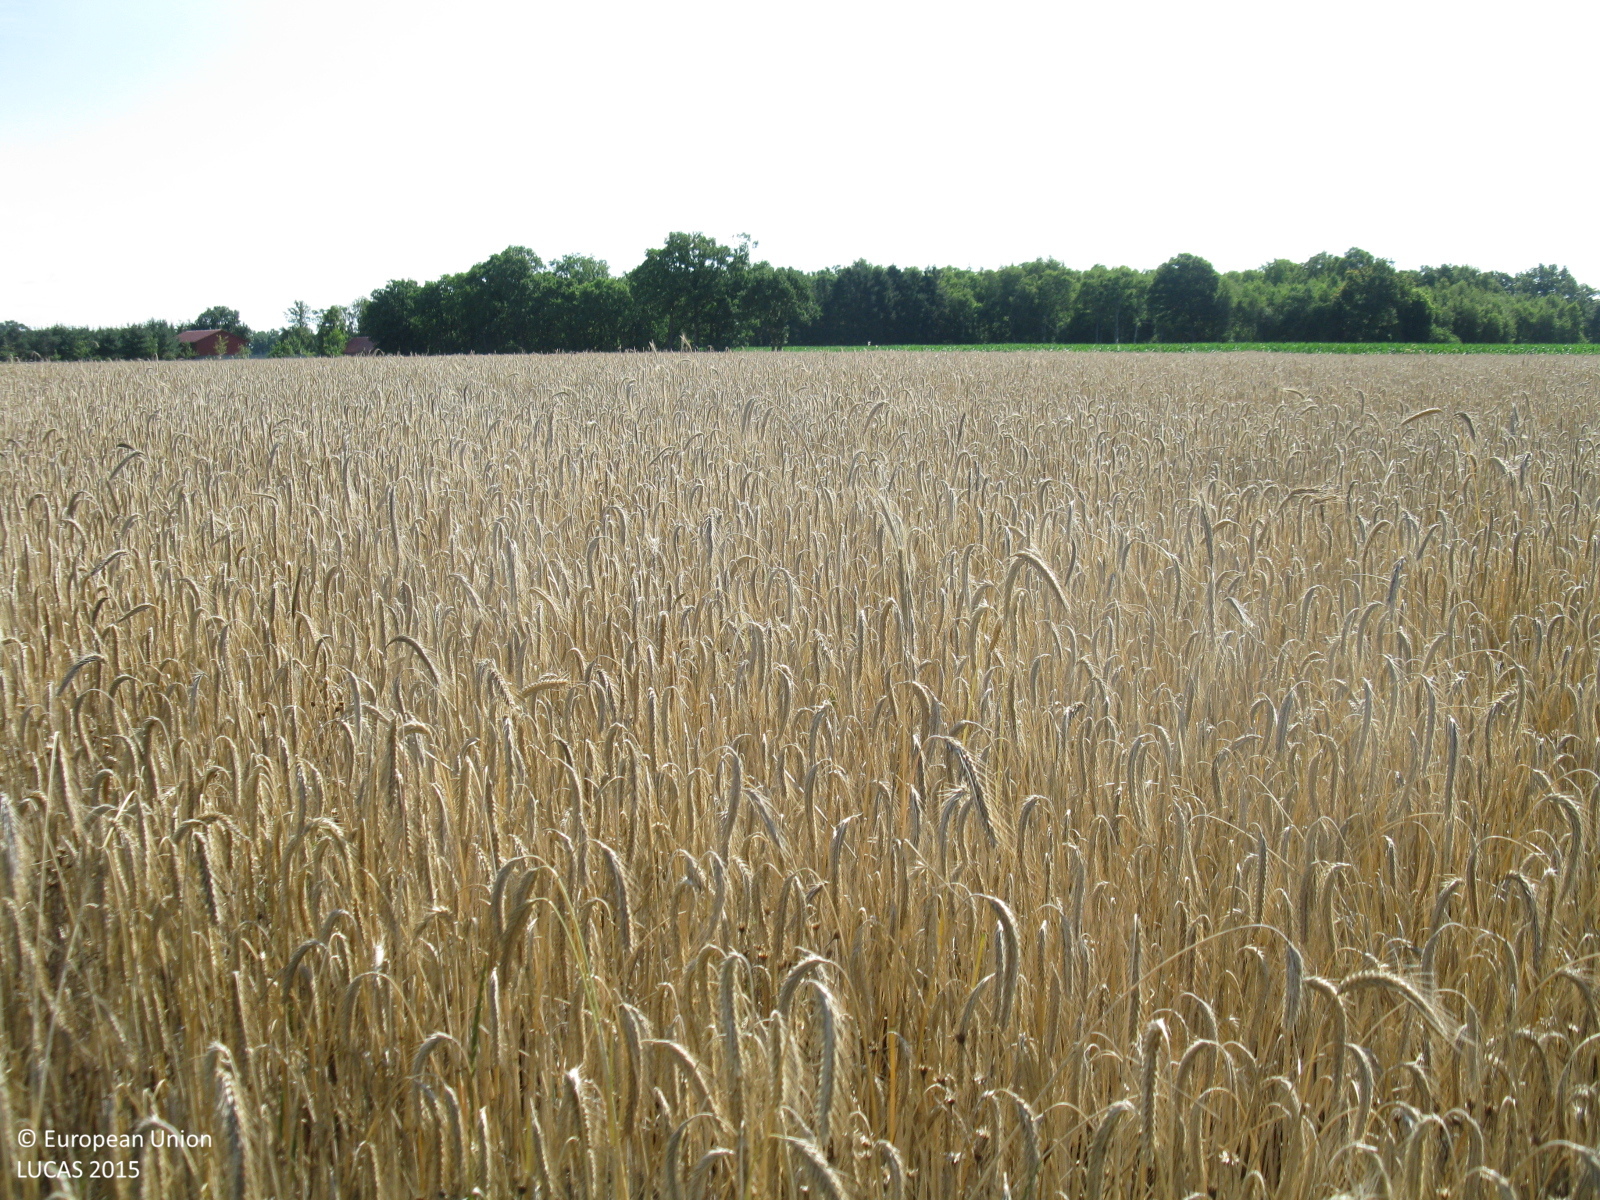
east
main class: Cropland
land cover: Triticale
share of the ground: > 75 %
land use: Agriculture (excluding fallow land and kitchen gardens)
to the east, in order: Triticale; Maize
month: July
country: DE
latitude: 52.9882
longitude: 7.9002
